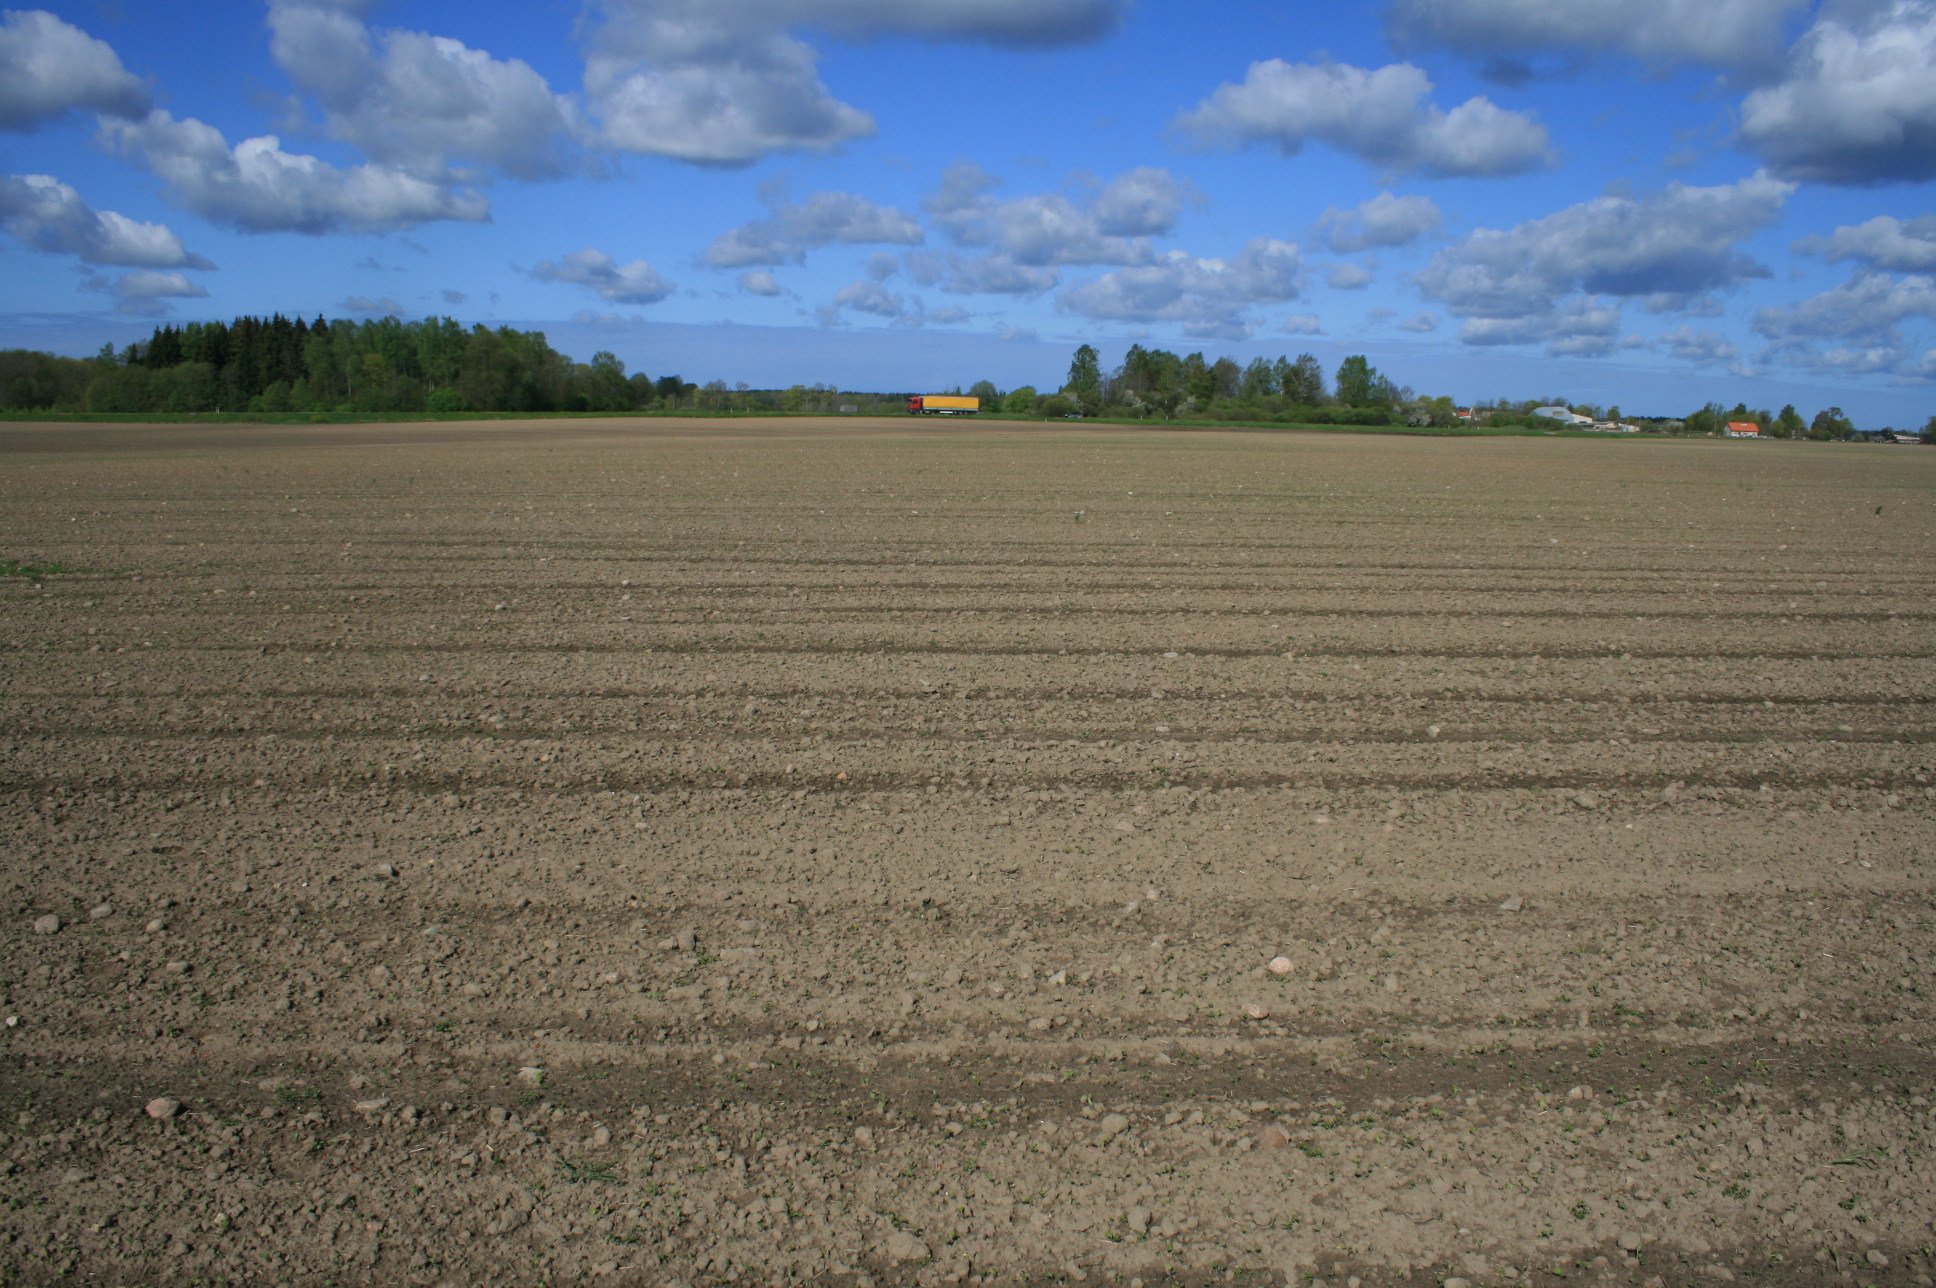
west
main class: Cropland
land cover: Dry pulses
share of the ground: < 10 %
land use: Agriculture (excluding fallow land and kitchen gardens)
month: May
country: LT
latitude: 56.2284
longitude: 21.5447
